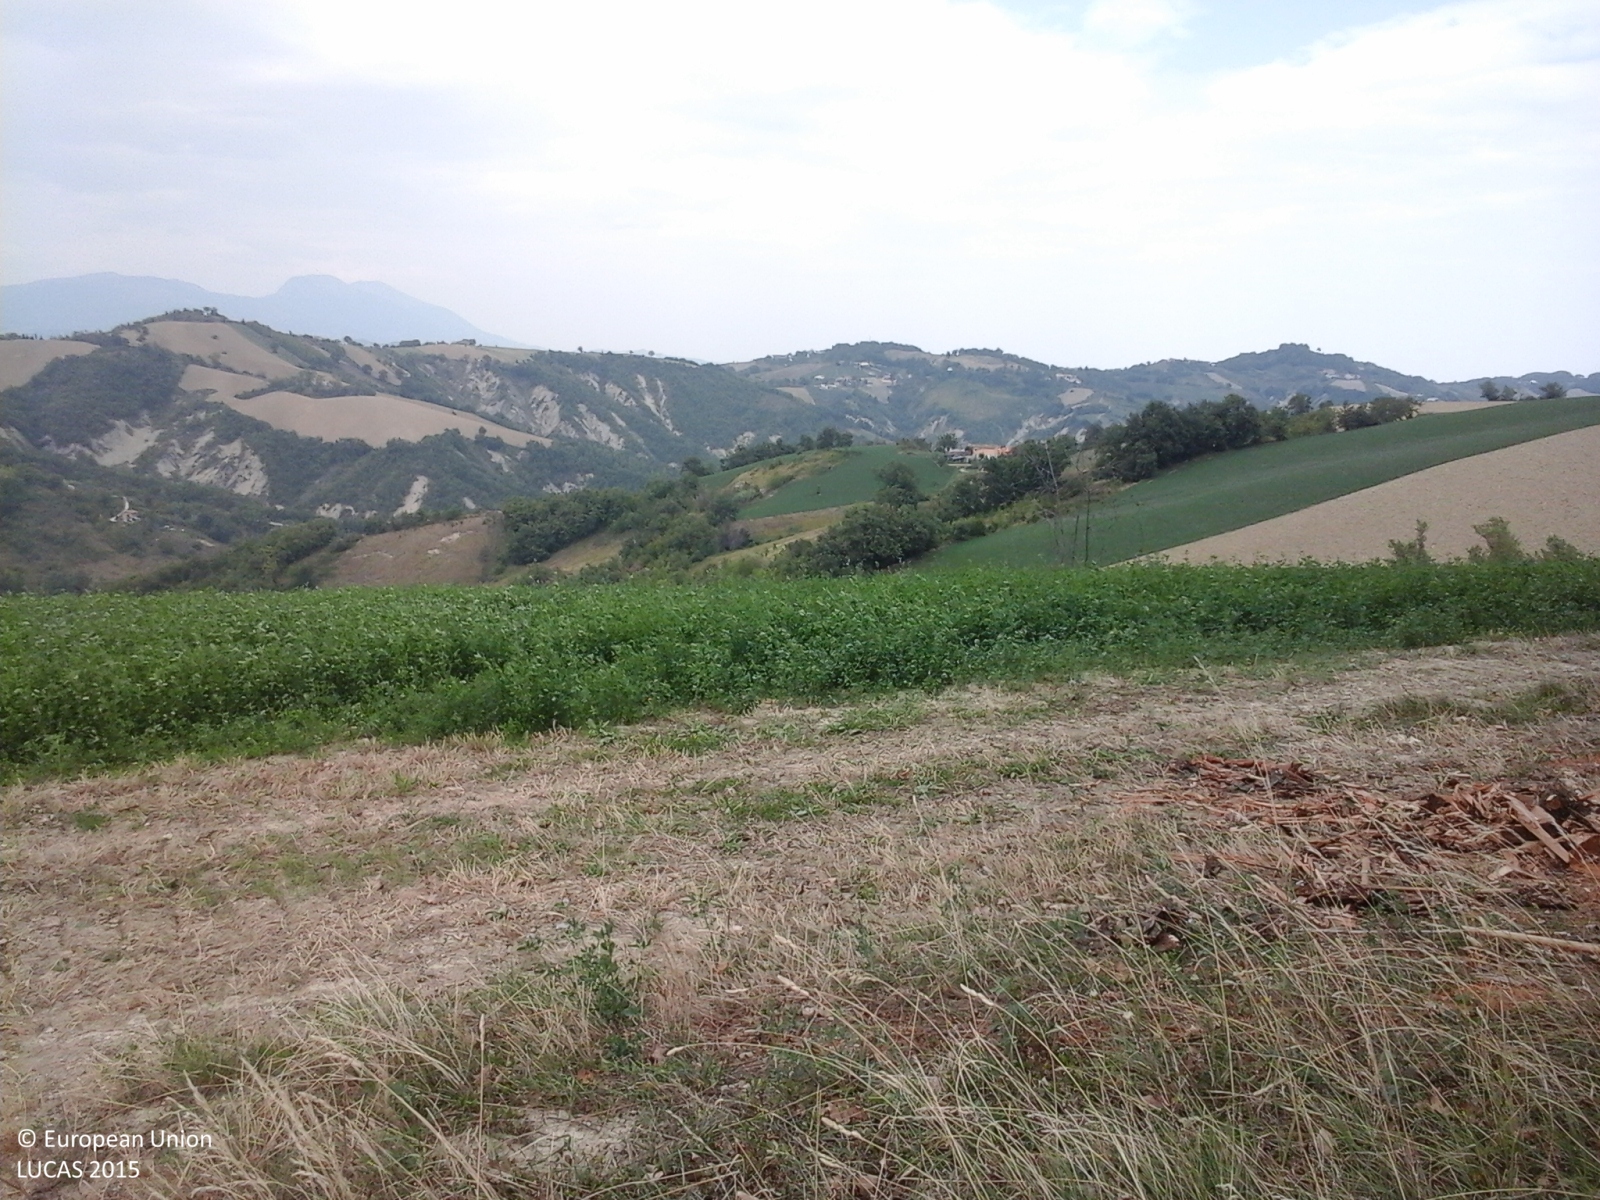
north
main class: Cropland
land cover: Lucerne
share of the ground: > 75 %
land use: Agriculture (excluding fallow land and kitchen gardens)
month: September
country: IT
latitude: 42.5123
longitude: 13.7495
